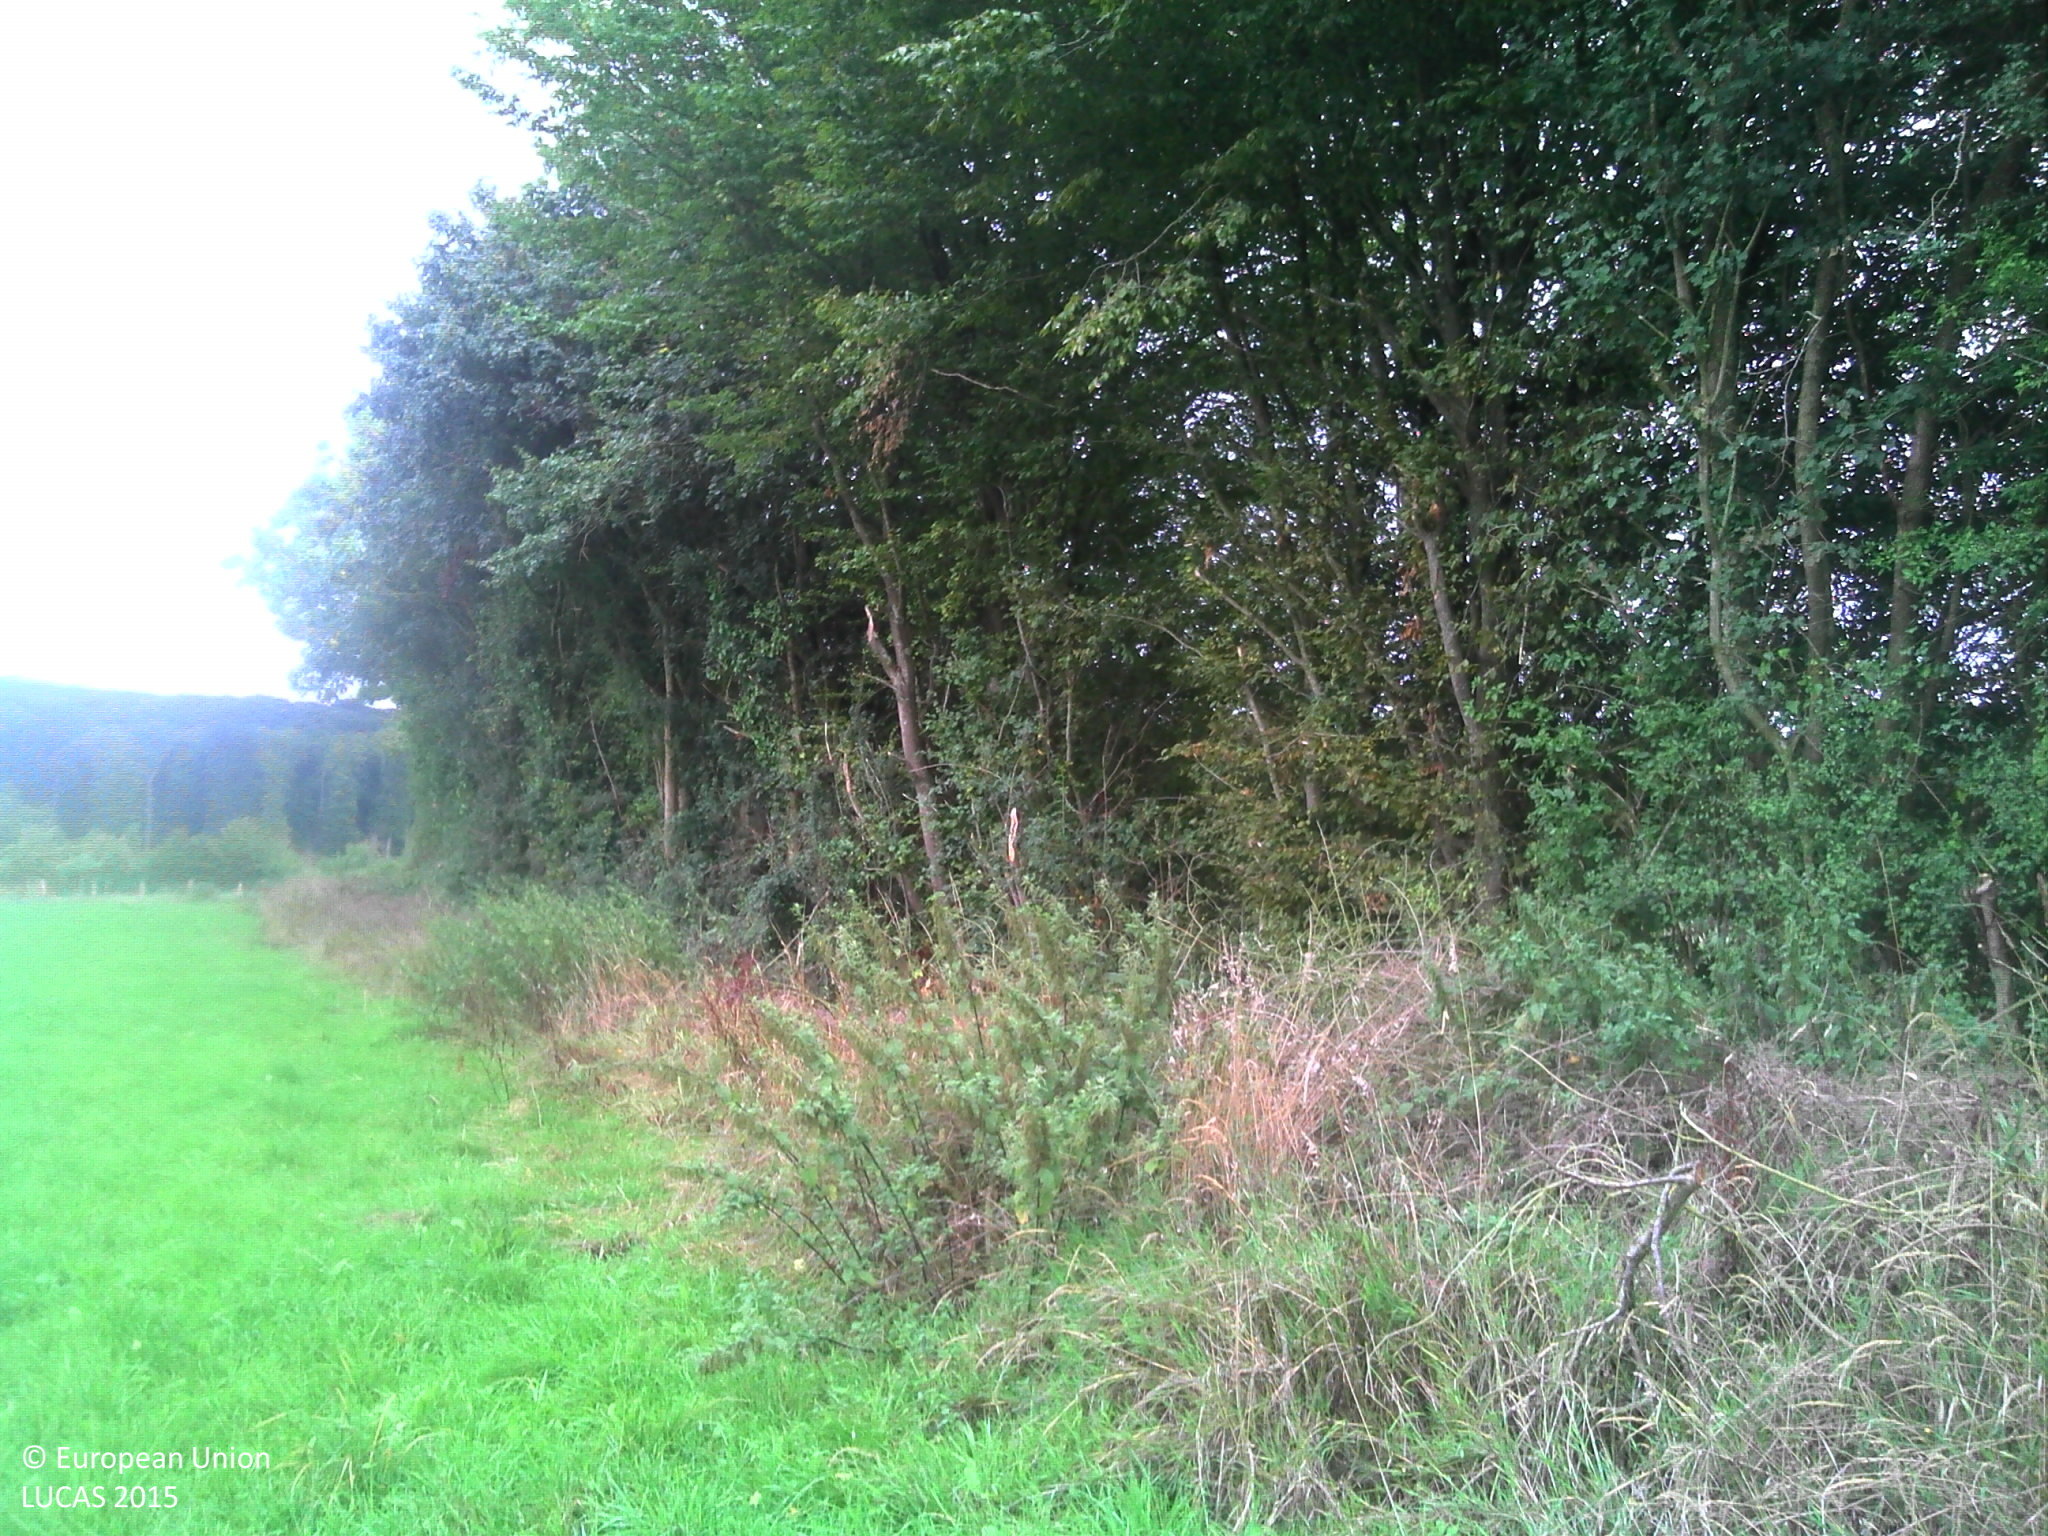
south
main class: Grassland
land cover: Grassland without tree/shrub cover
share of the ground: > 75 %
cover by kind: herbaceous plants 100 %
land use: Agriculture (excluding fallow land and kitchen gardens)
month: August
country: FR
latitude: 48.4153
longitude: 0.5586
